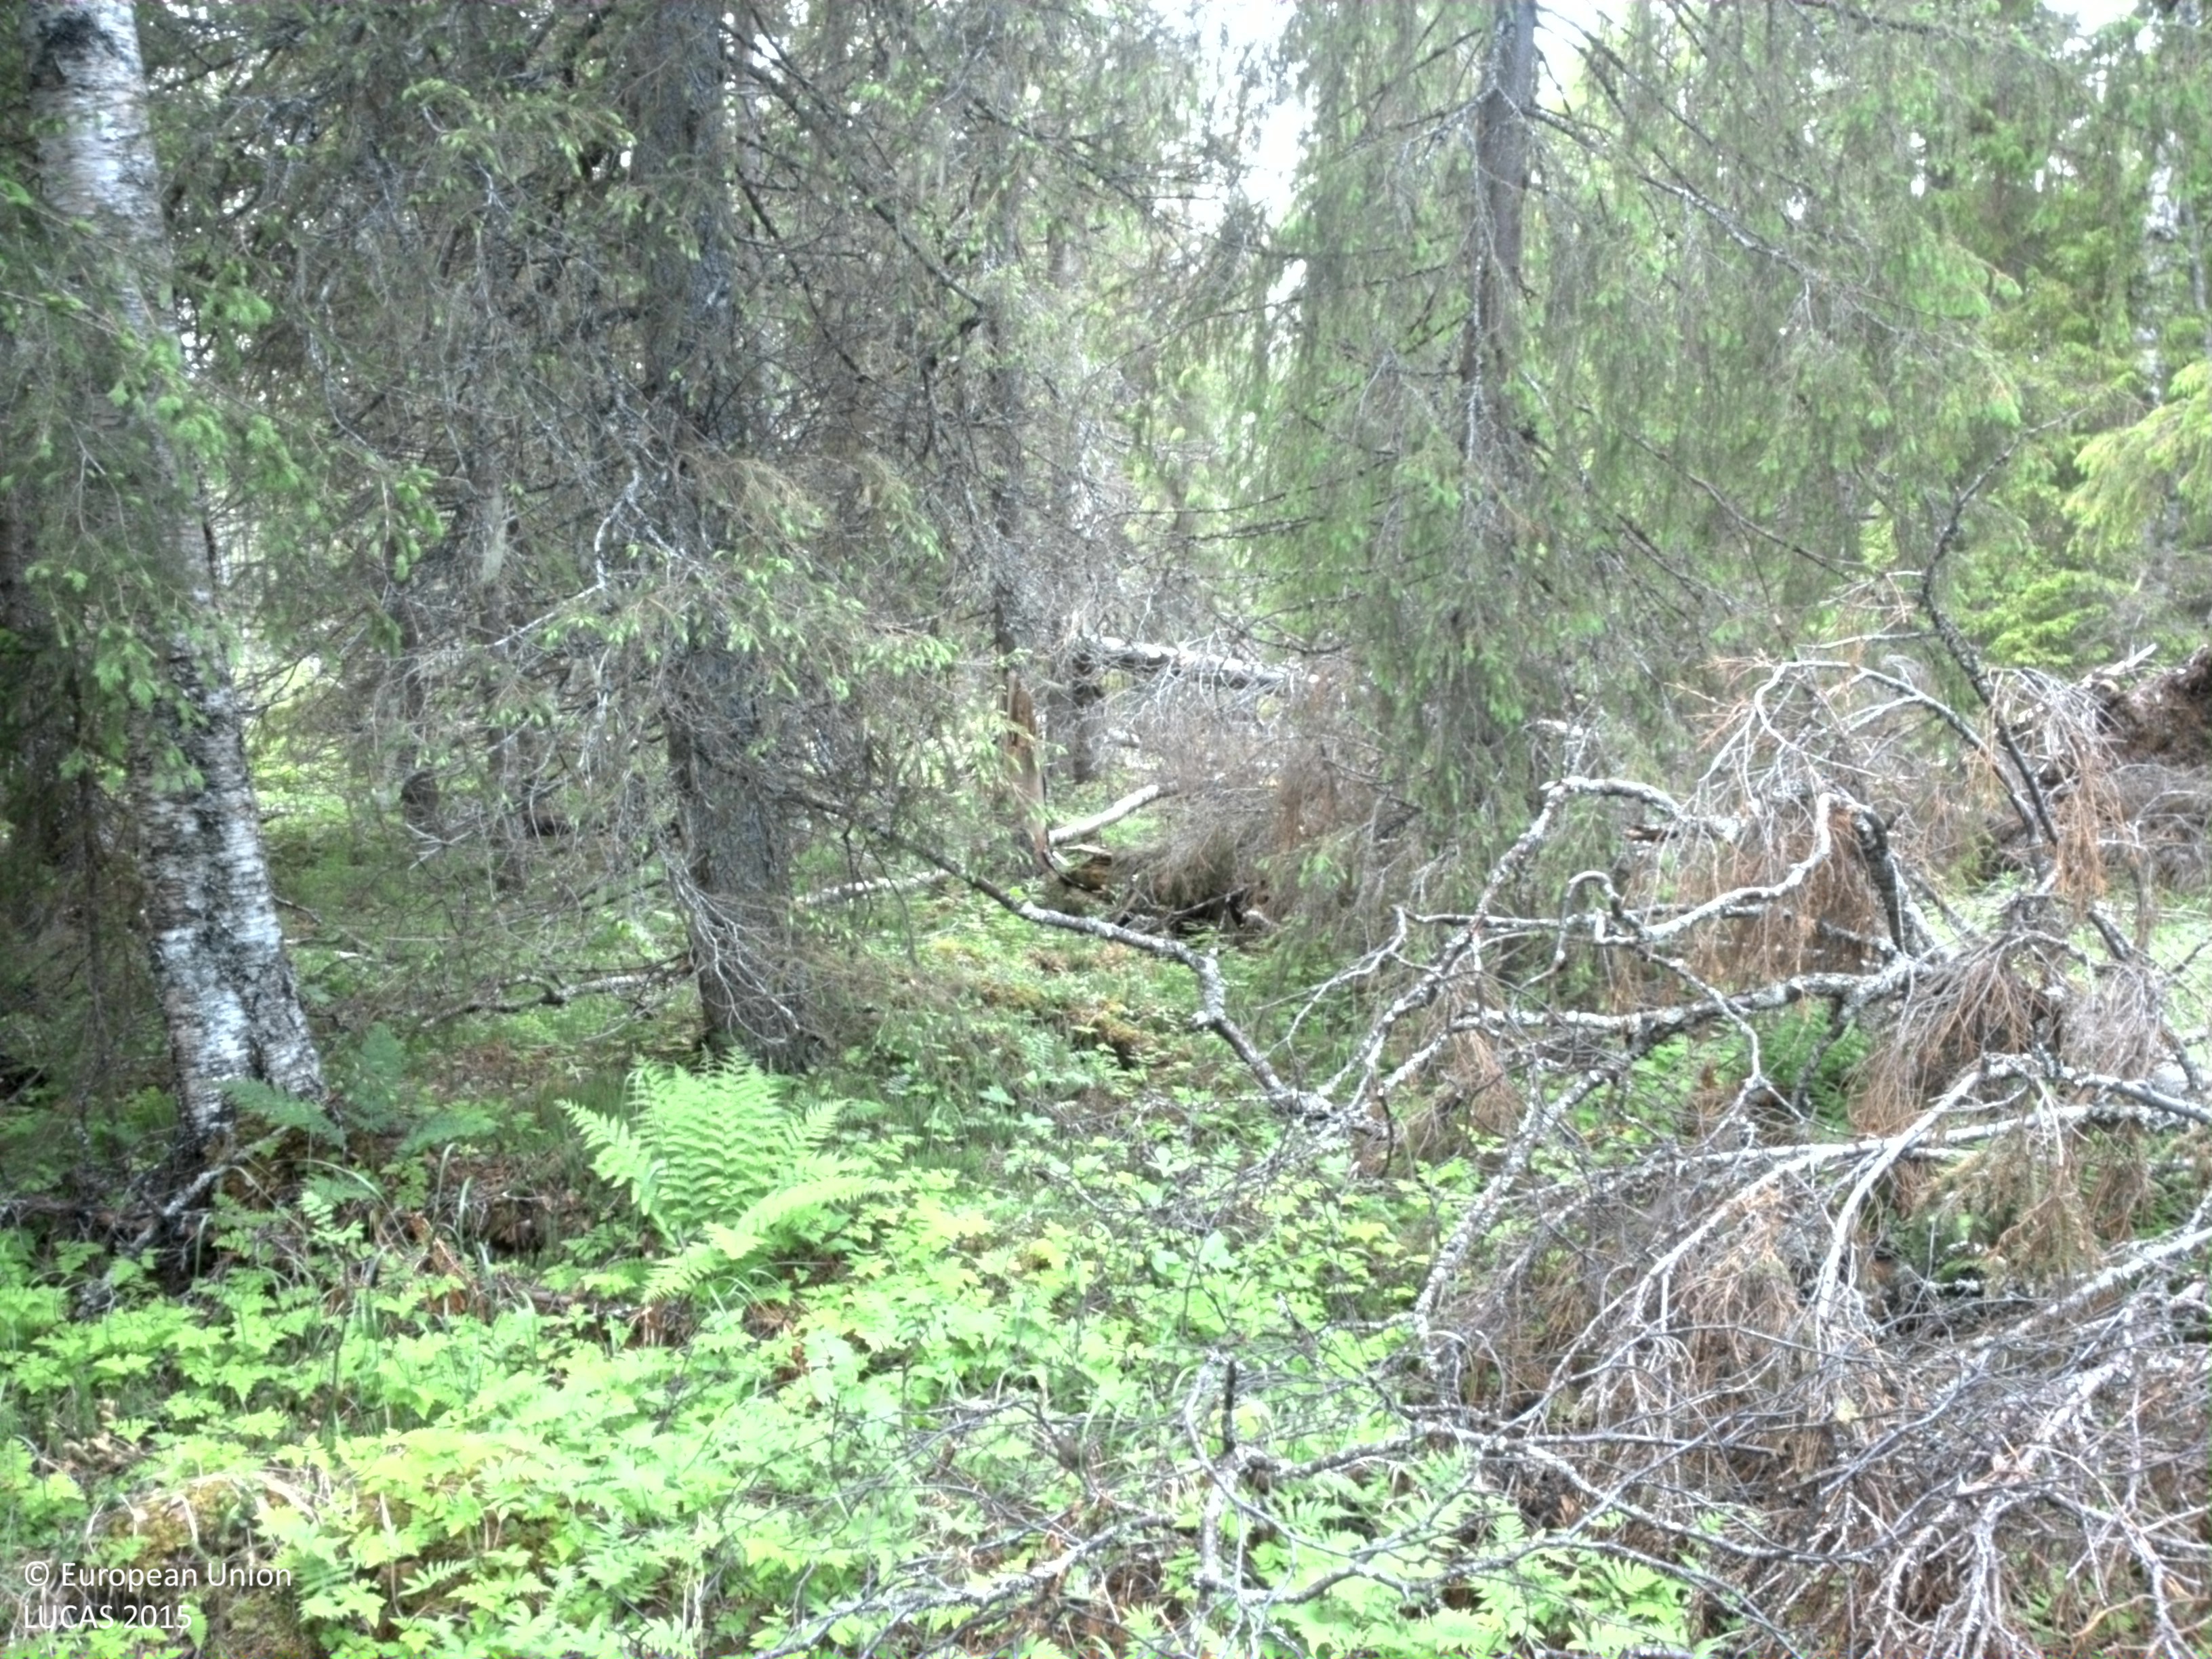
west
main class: Woodland
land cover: Spruce dominated coniferous woodland
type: boreal forest
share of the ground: 50 - 75 %
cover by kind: coniferous forest trees 70 %, herbaceous plants 25 %, broadleaved forest trees 5 %
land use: Forestry
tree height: > 5 m
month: July
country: SE
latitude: 64.5175
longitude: 18.1128
